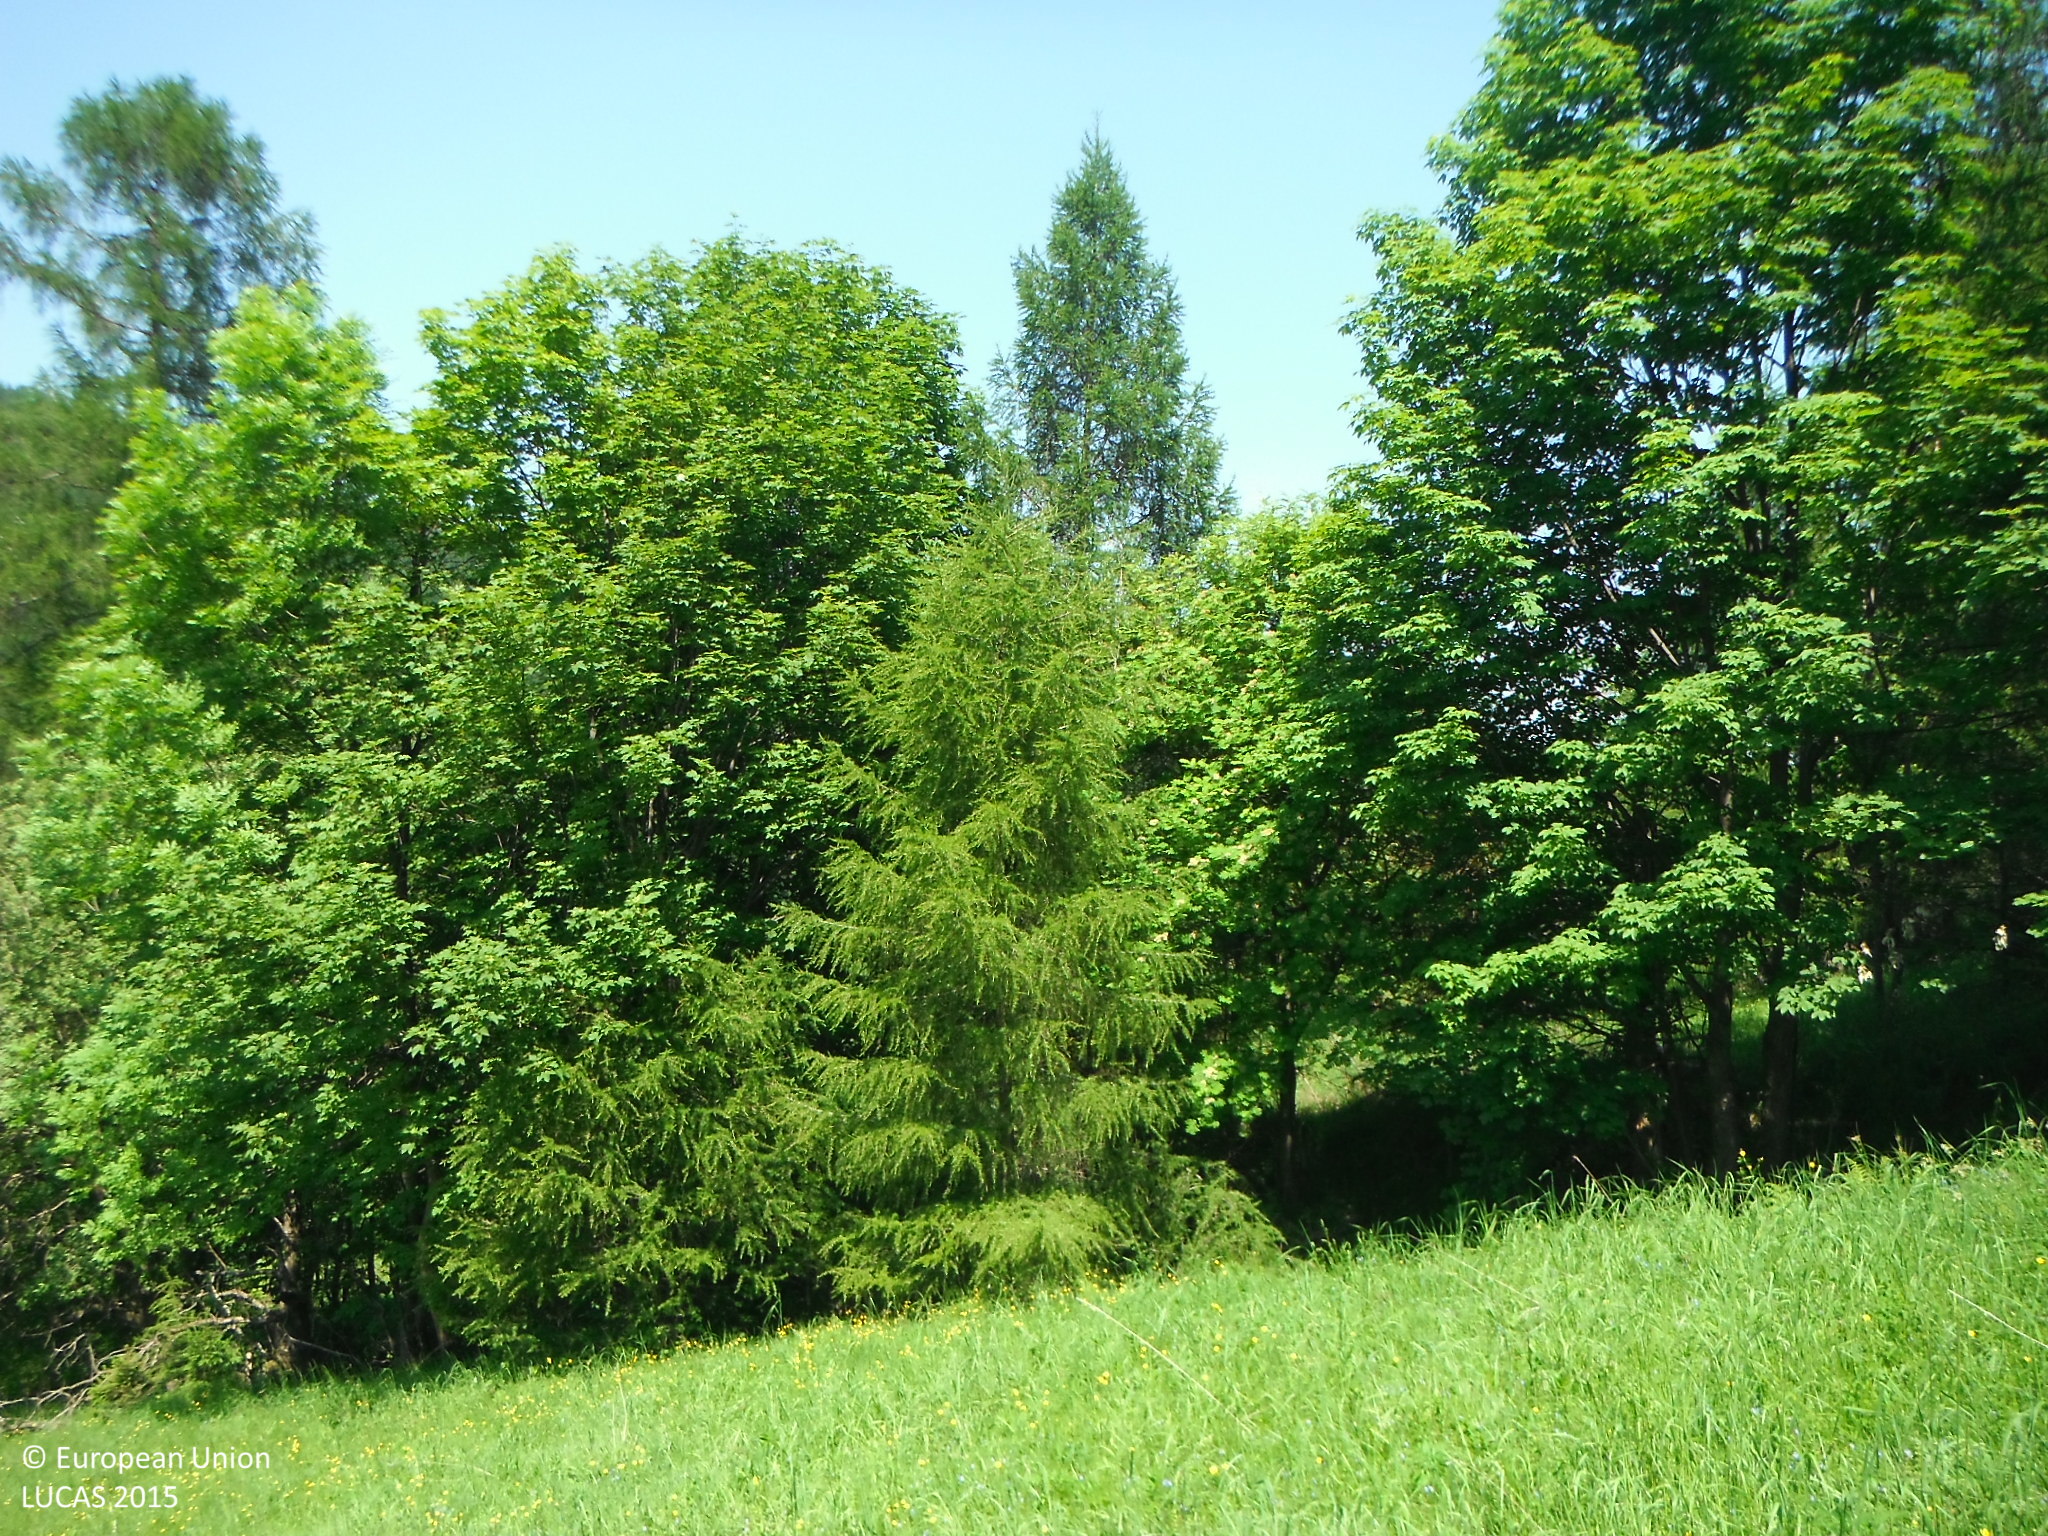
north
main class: Grassland
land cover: Grassland without tree/shrub cover
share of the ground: > 75 %
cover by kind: herbaceous plants 100 %
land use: Agriculture (excluding fallow land and kitchen gardens)
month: June
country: SK
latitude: 49.2963
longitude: 20.3341
